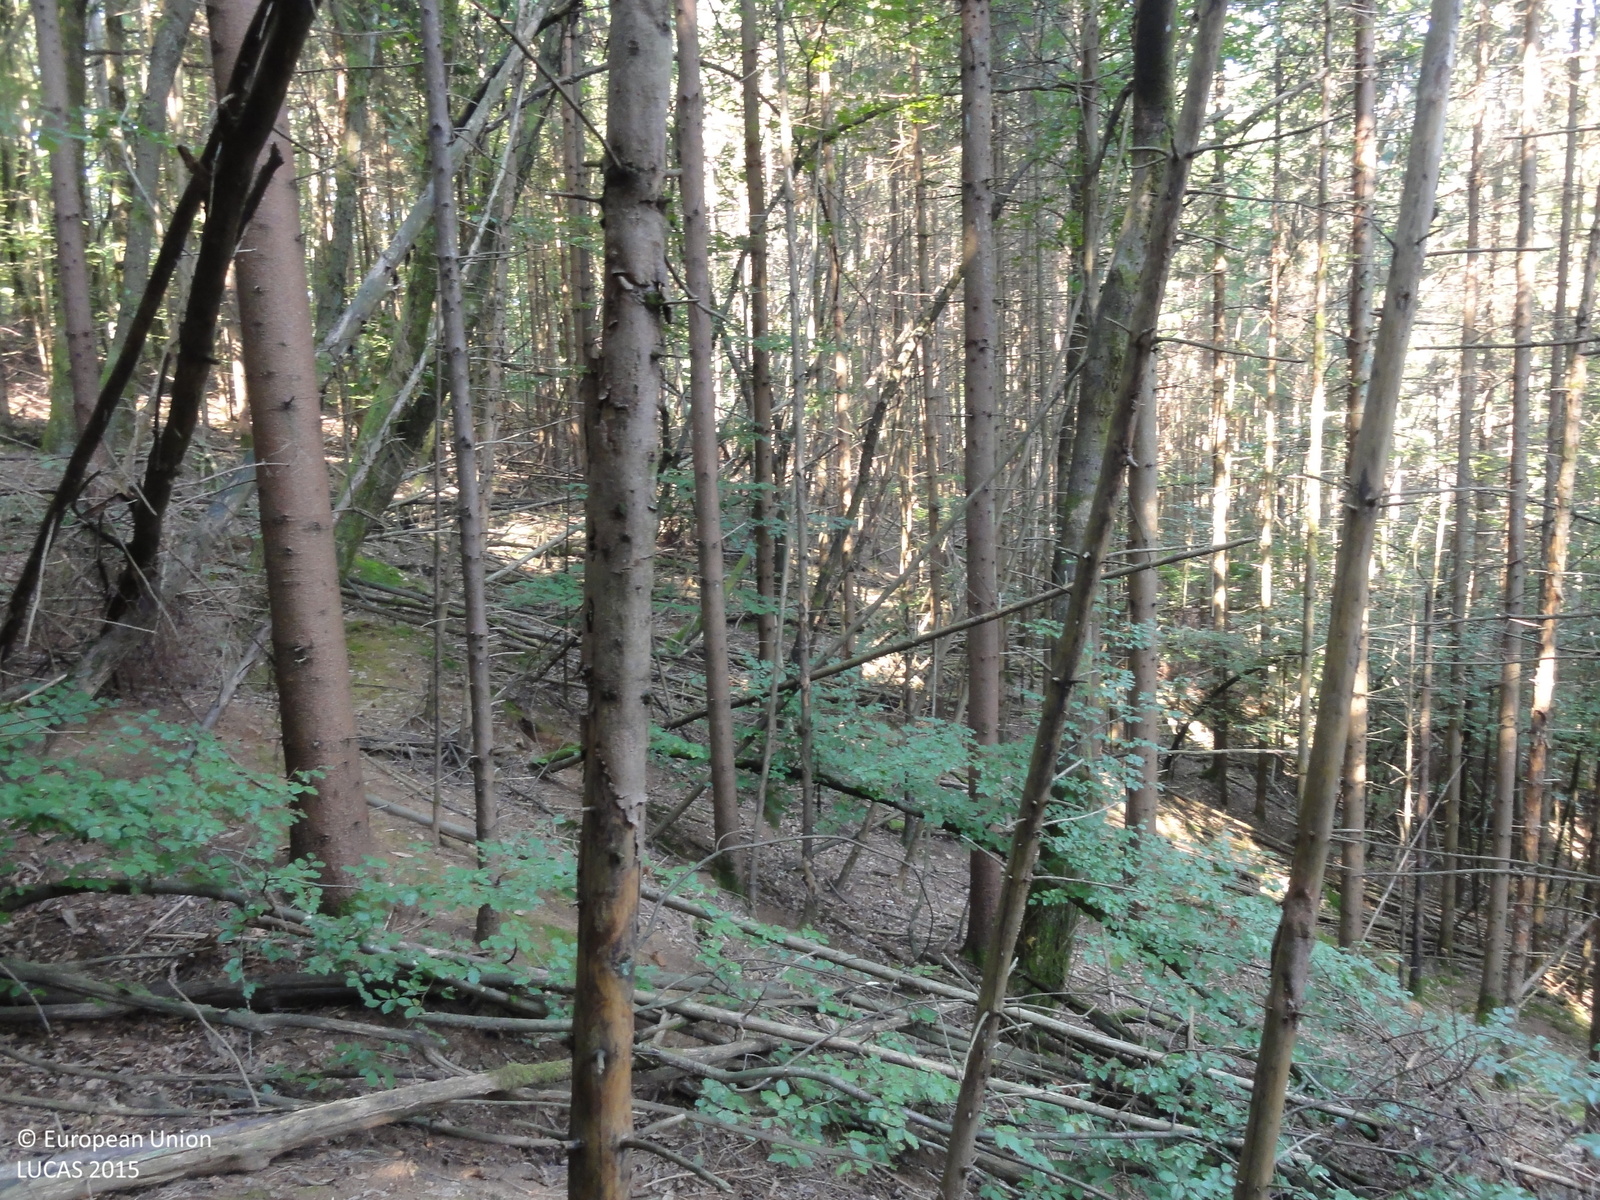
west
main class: Woodland
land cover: Spruce dominated mixed woodland
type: mountainous beech forest
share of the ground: > 75 %
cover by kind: coniferous forest trees 65 %, broadleaved forest trees 30 %, herbaceous plants 5 %
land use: Forestry
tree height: > 5 m
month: August
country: SI
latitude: 45.8897
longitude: 15.0354
